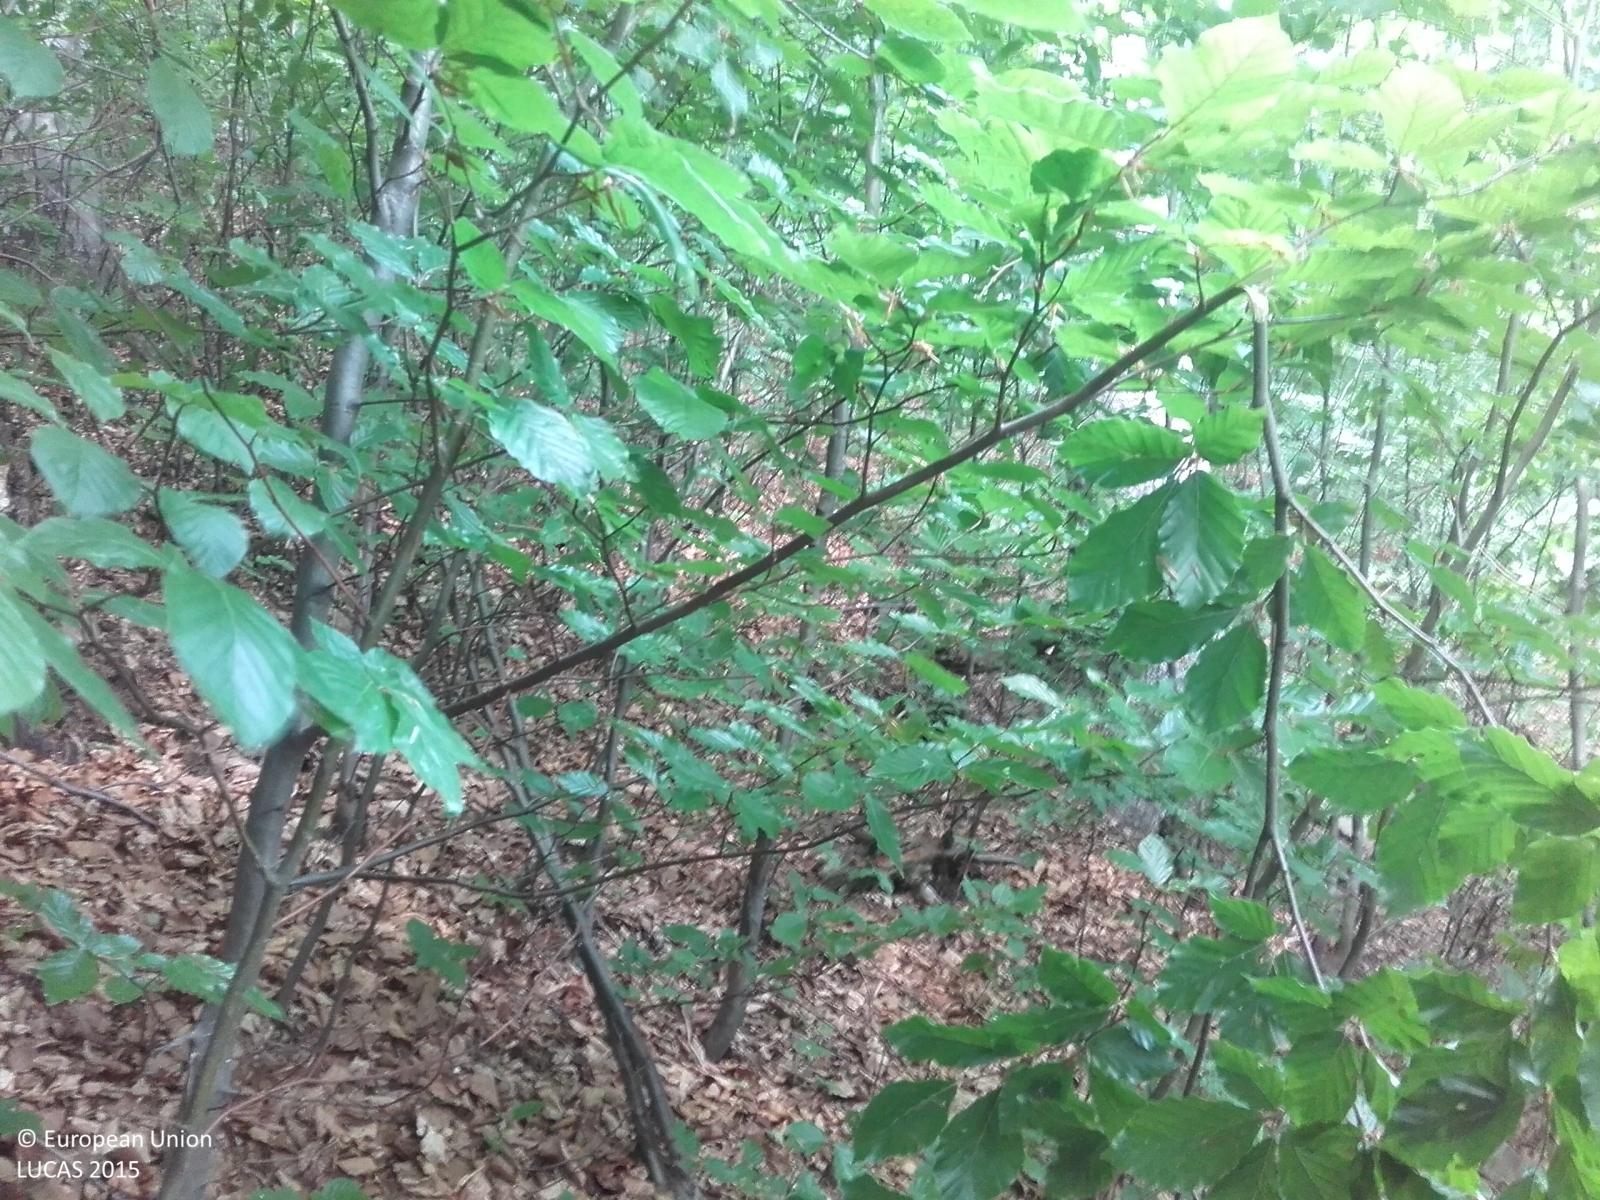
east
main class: Woodland
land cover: Broadleaved woodland
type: mesophytic deciduous forest
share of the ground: > 75 %
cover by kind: broadleaved forest trees 100 %
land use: Forestry
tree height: > 5 m
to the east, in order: Broadleaved woodland; Tracks; Broadleaved woodland; Tracks; Broadleaved woodland; Other mixed woodland
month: June
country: CZ
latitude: 49.6076
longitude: 18.8083
